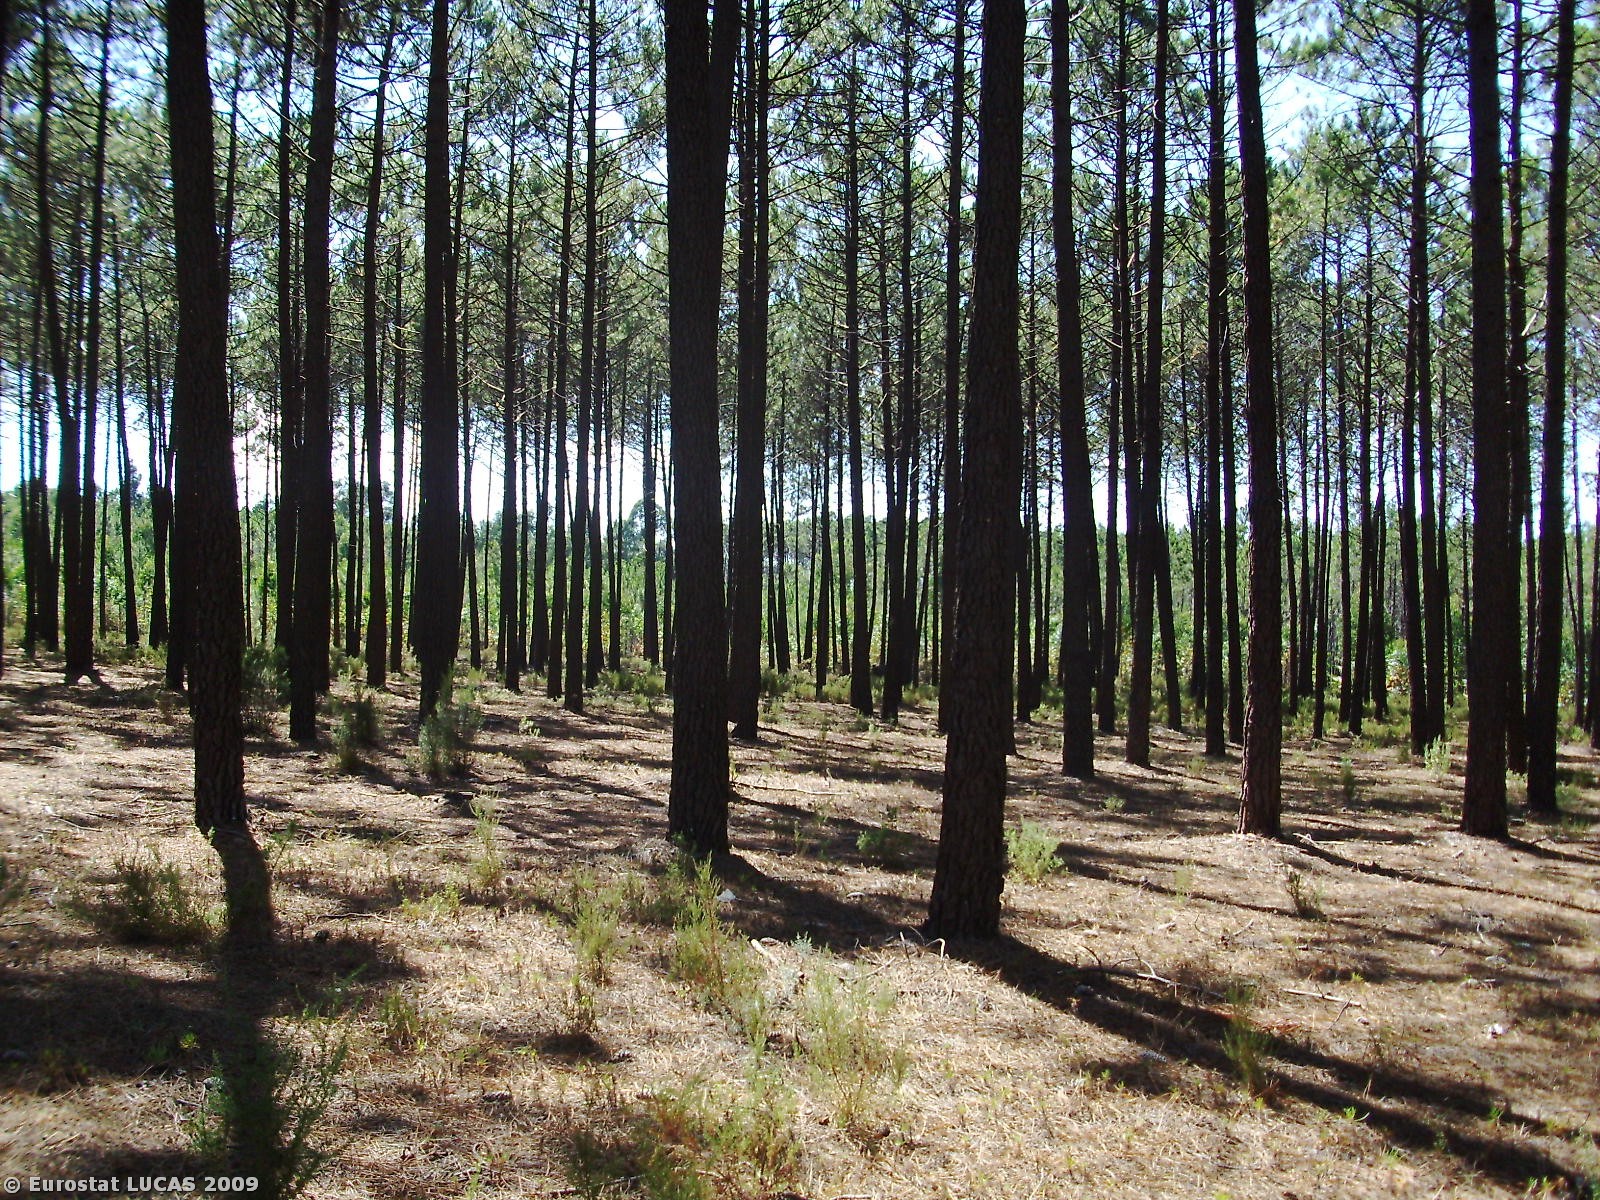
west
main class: Woodland
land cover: Coniferous woodland
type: coniferous forest of the mediterranean region
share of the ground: > 75 %
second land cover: Shrubland with sparse tree cover
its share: 10 - 25 %
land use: Forestry
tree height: > 5 m
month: July
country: PT
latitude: 39.7160
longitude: -8.9520
